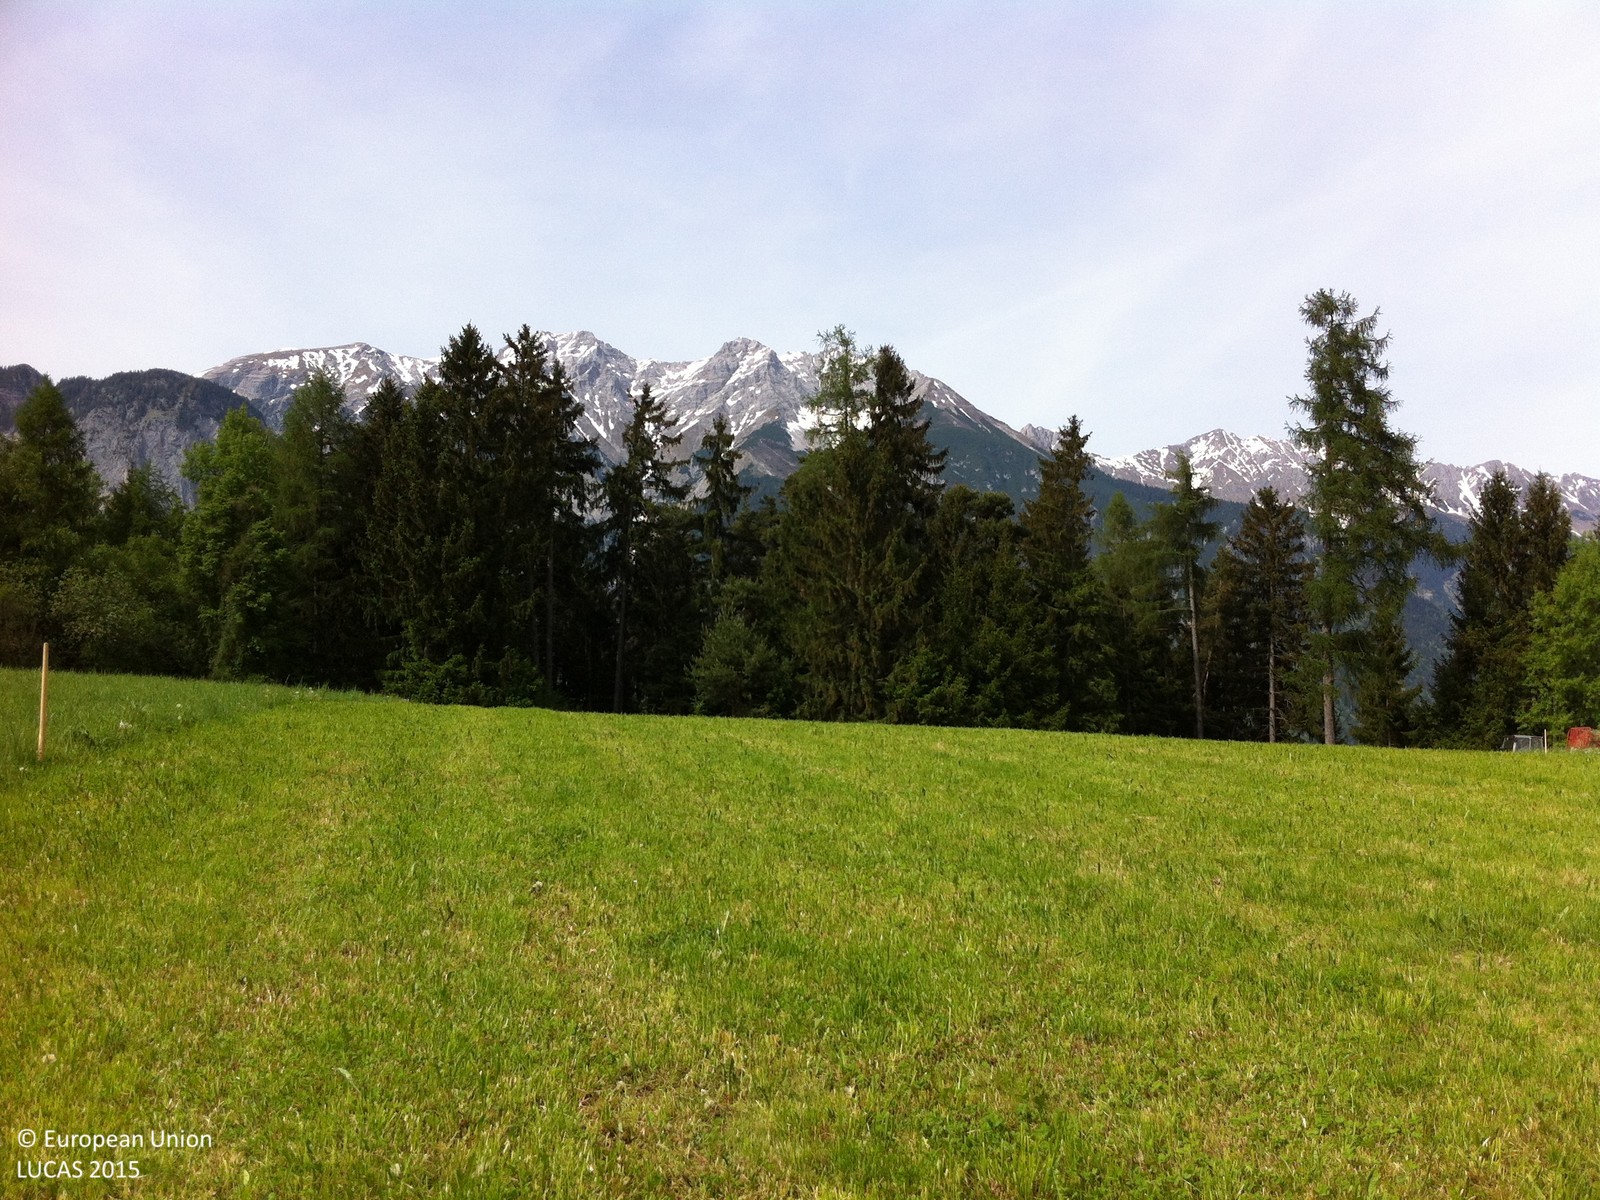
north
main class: Cropland
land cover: Temporary grasslands
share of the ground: > 75 %
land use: Agriculture (excluding fallow land and kitchen gardens)
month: May
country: AT
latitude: 47.2434
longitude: 11.3331
